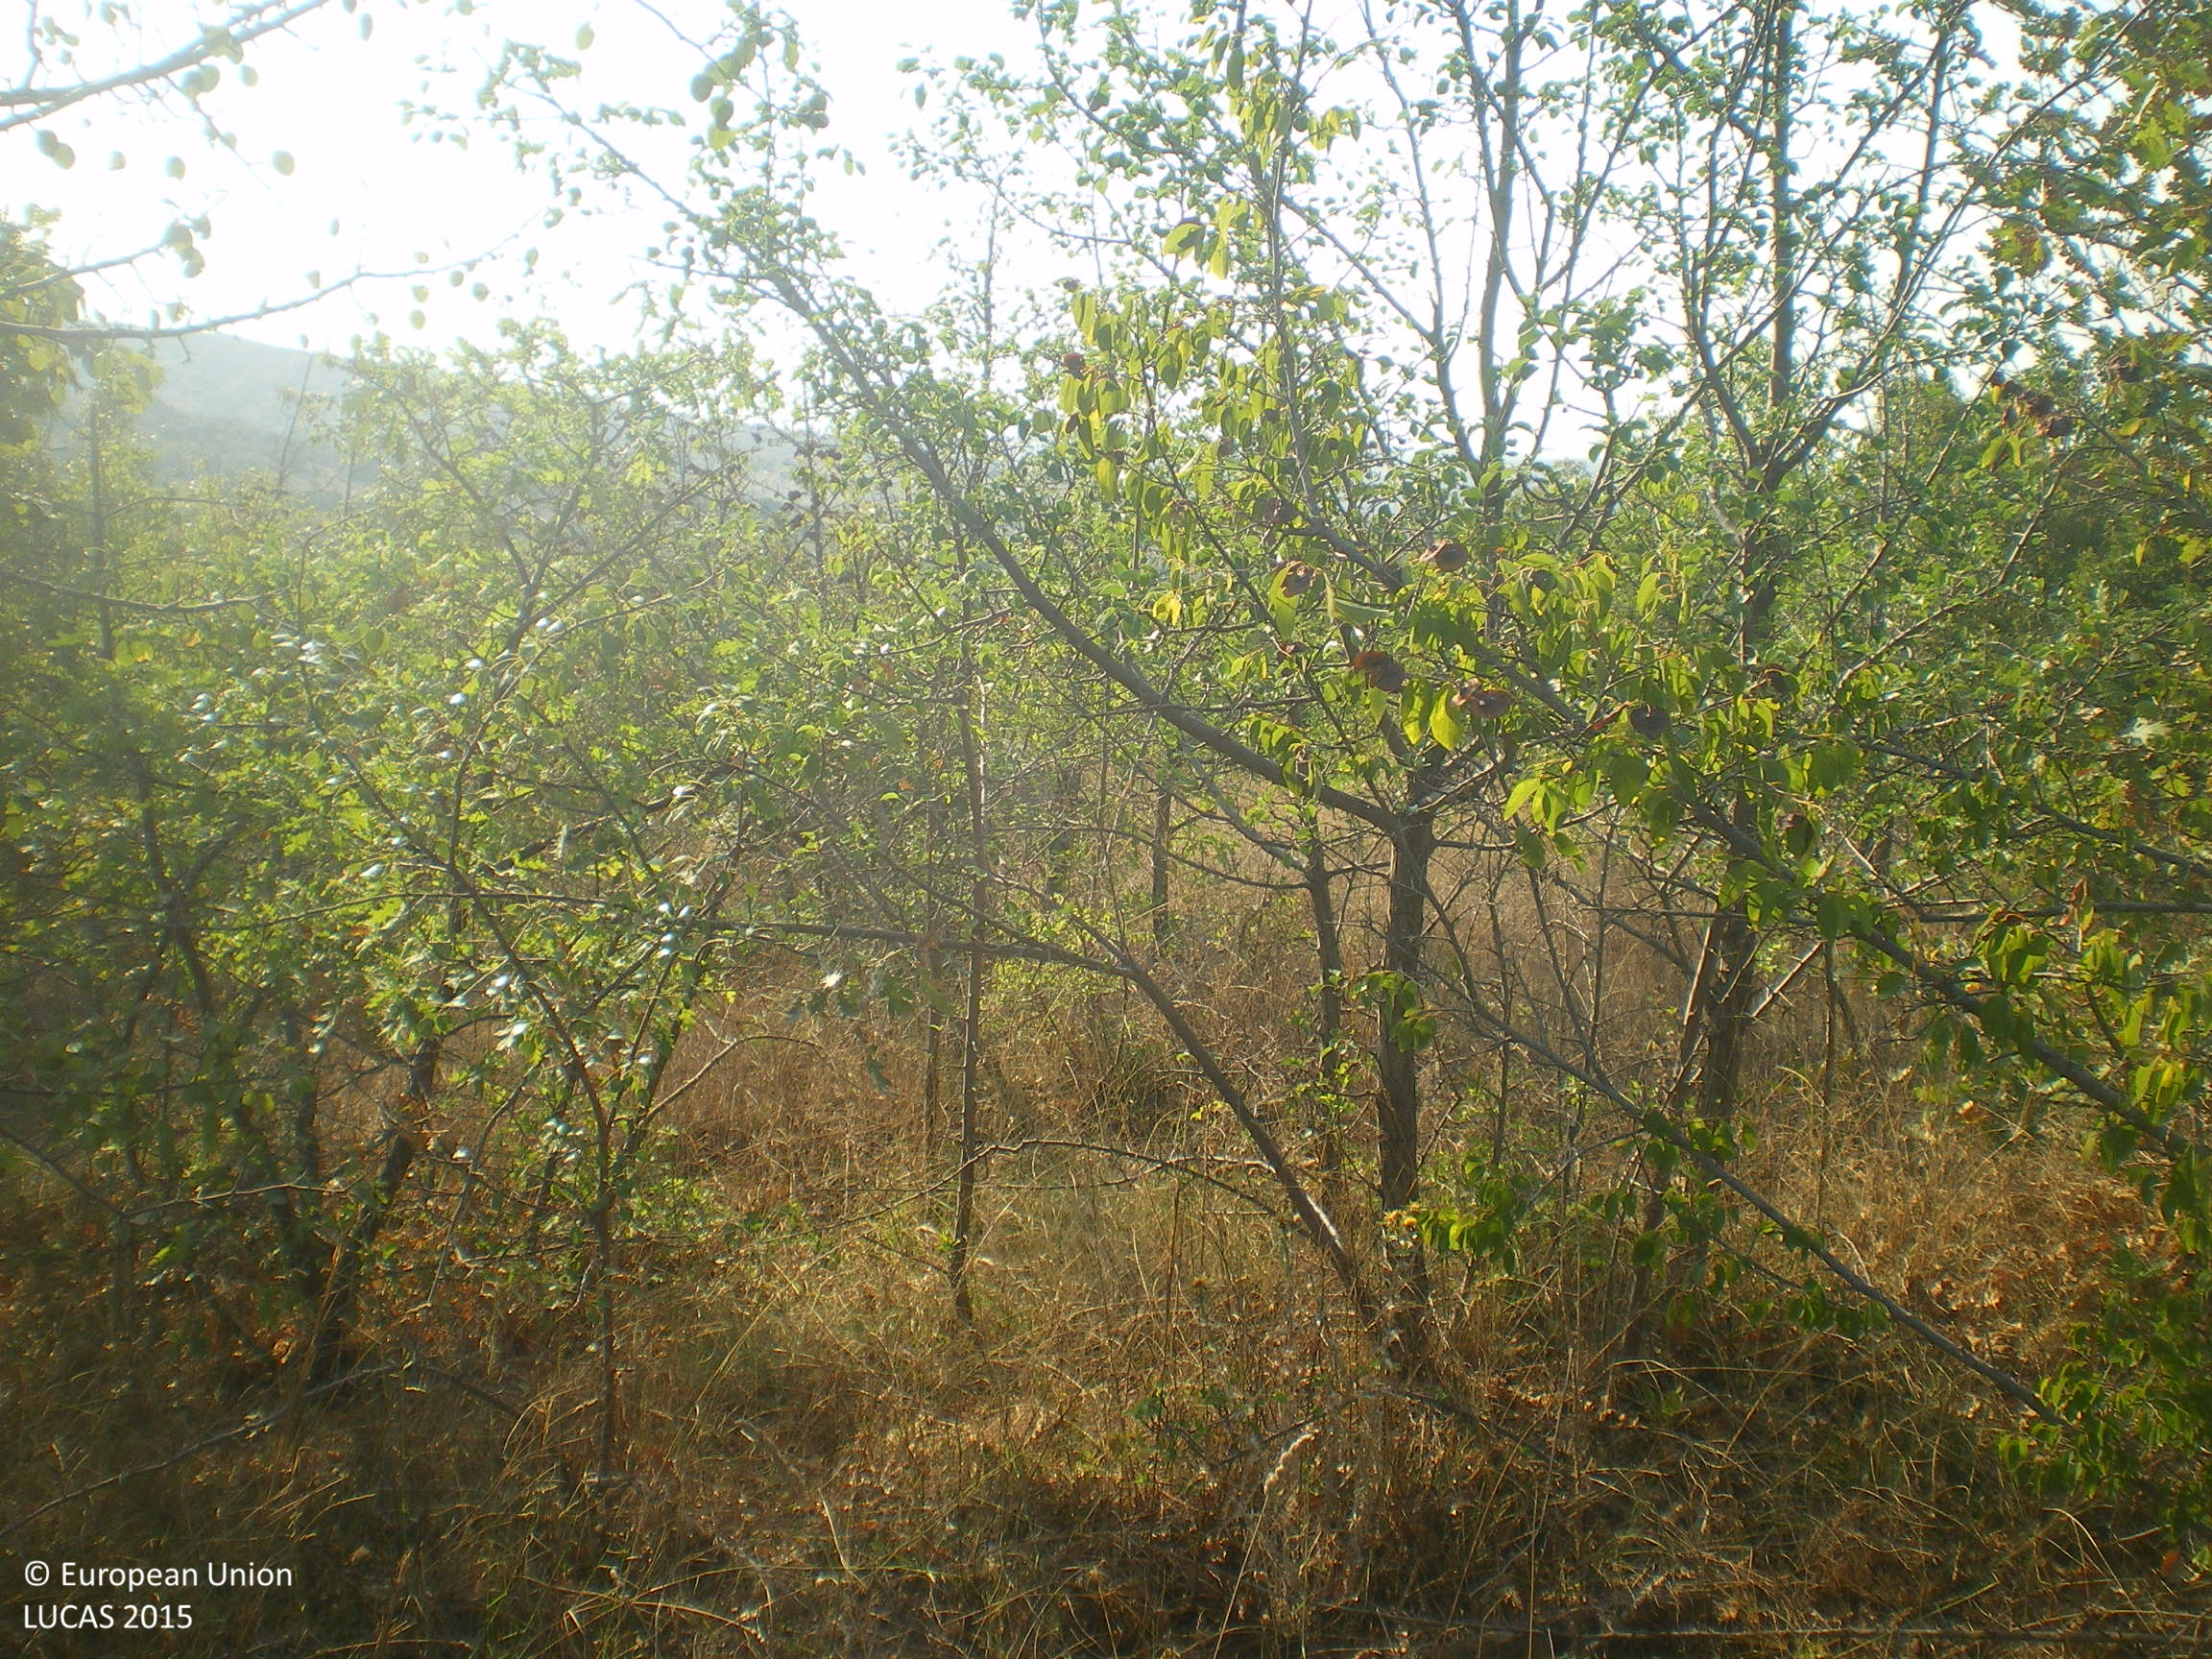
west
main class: Woodland
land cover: Broadleaved woodland
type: acidophilous oak and oak-birch forest
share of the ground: 10 - 25 %
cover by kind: shrubs 80 %, broadleaved forest trees 20 %
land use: Forestry
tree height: > 5 m
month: August
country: BG
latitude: 41.9083
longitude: 25.7522
